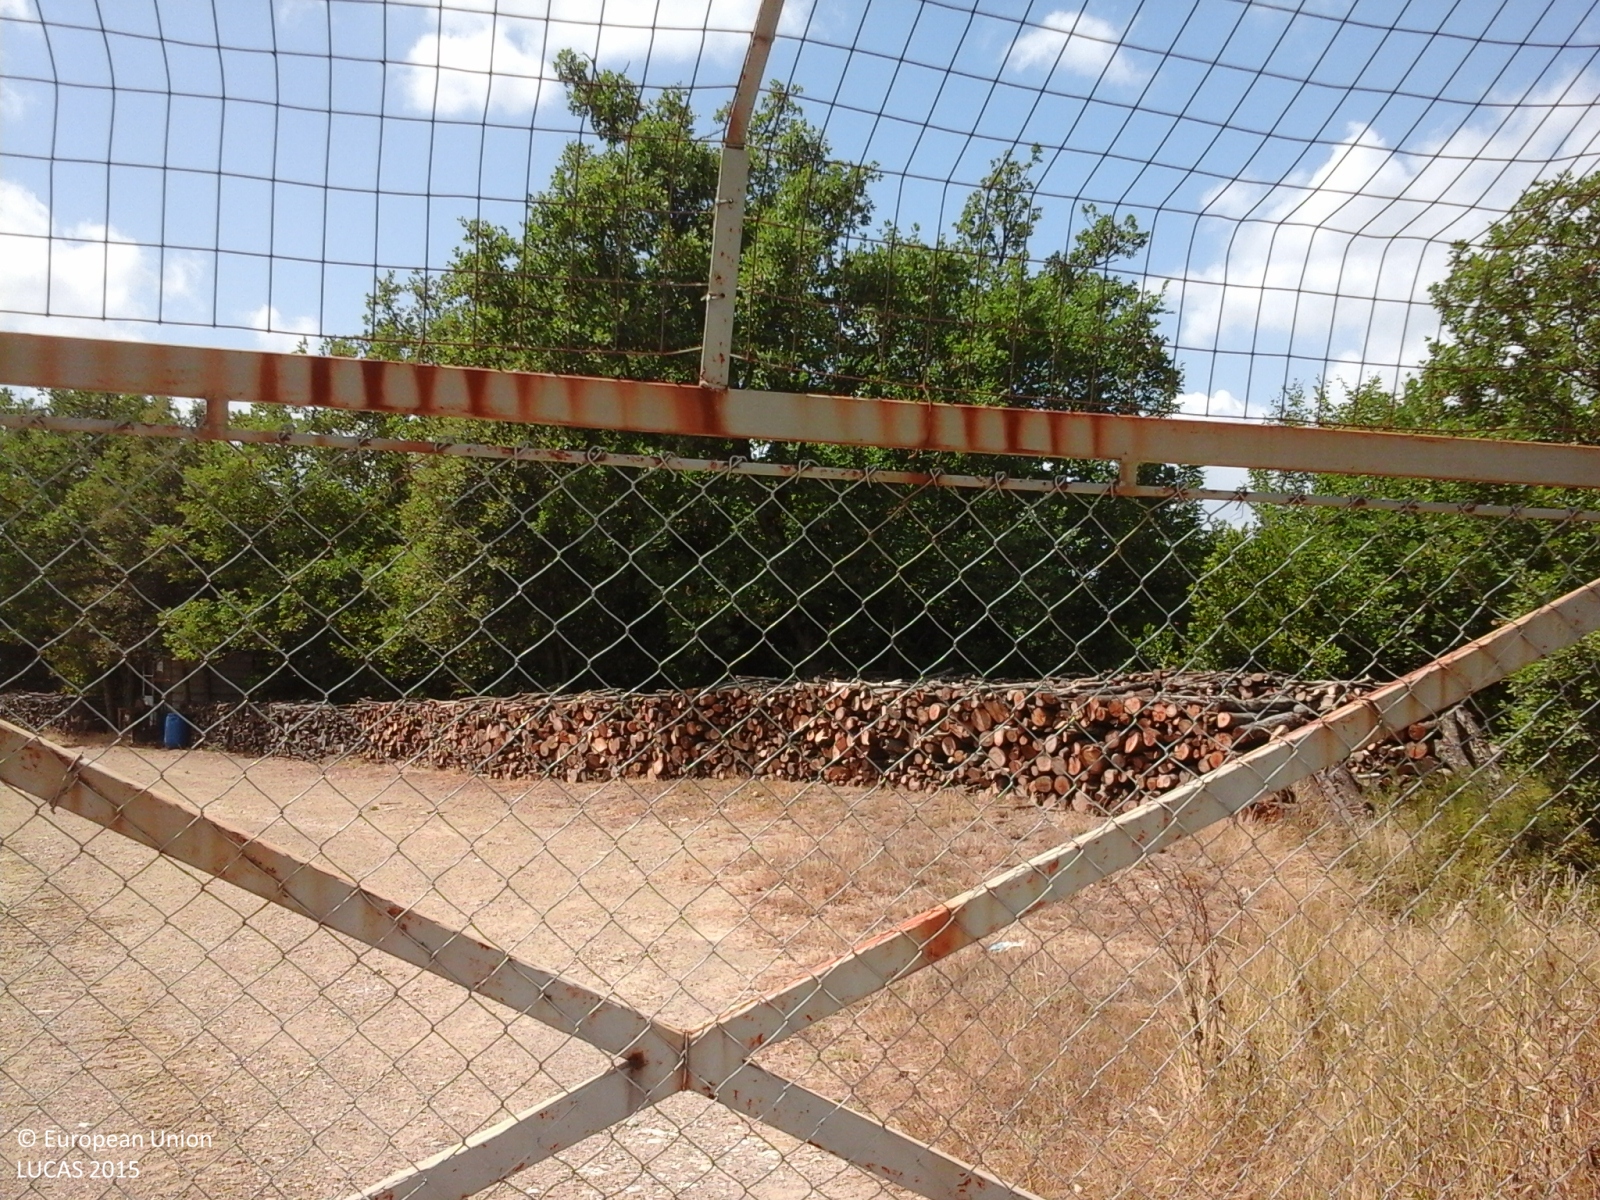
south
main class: Grassland
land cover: Grassland with sparse tree/shrub cover
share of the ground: > 75 %
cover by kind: herbaceous plants 85 %, shrubs 10 %, broadleaved forest trees 5 %
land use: Agriculture (excluding fallow land and kitchen gardens)
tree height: < 5 m
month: February
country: IT
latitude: 43.4443
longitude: 10.9241
